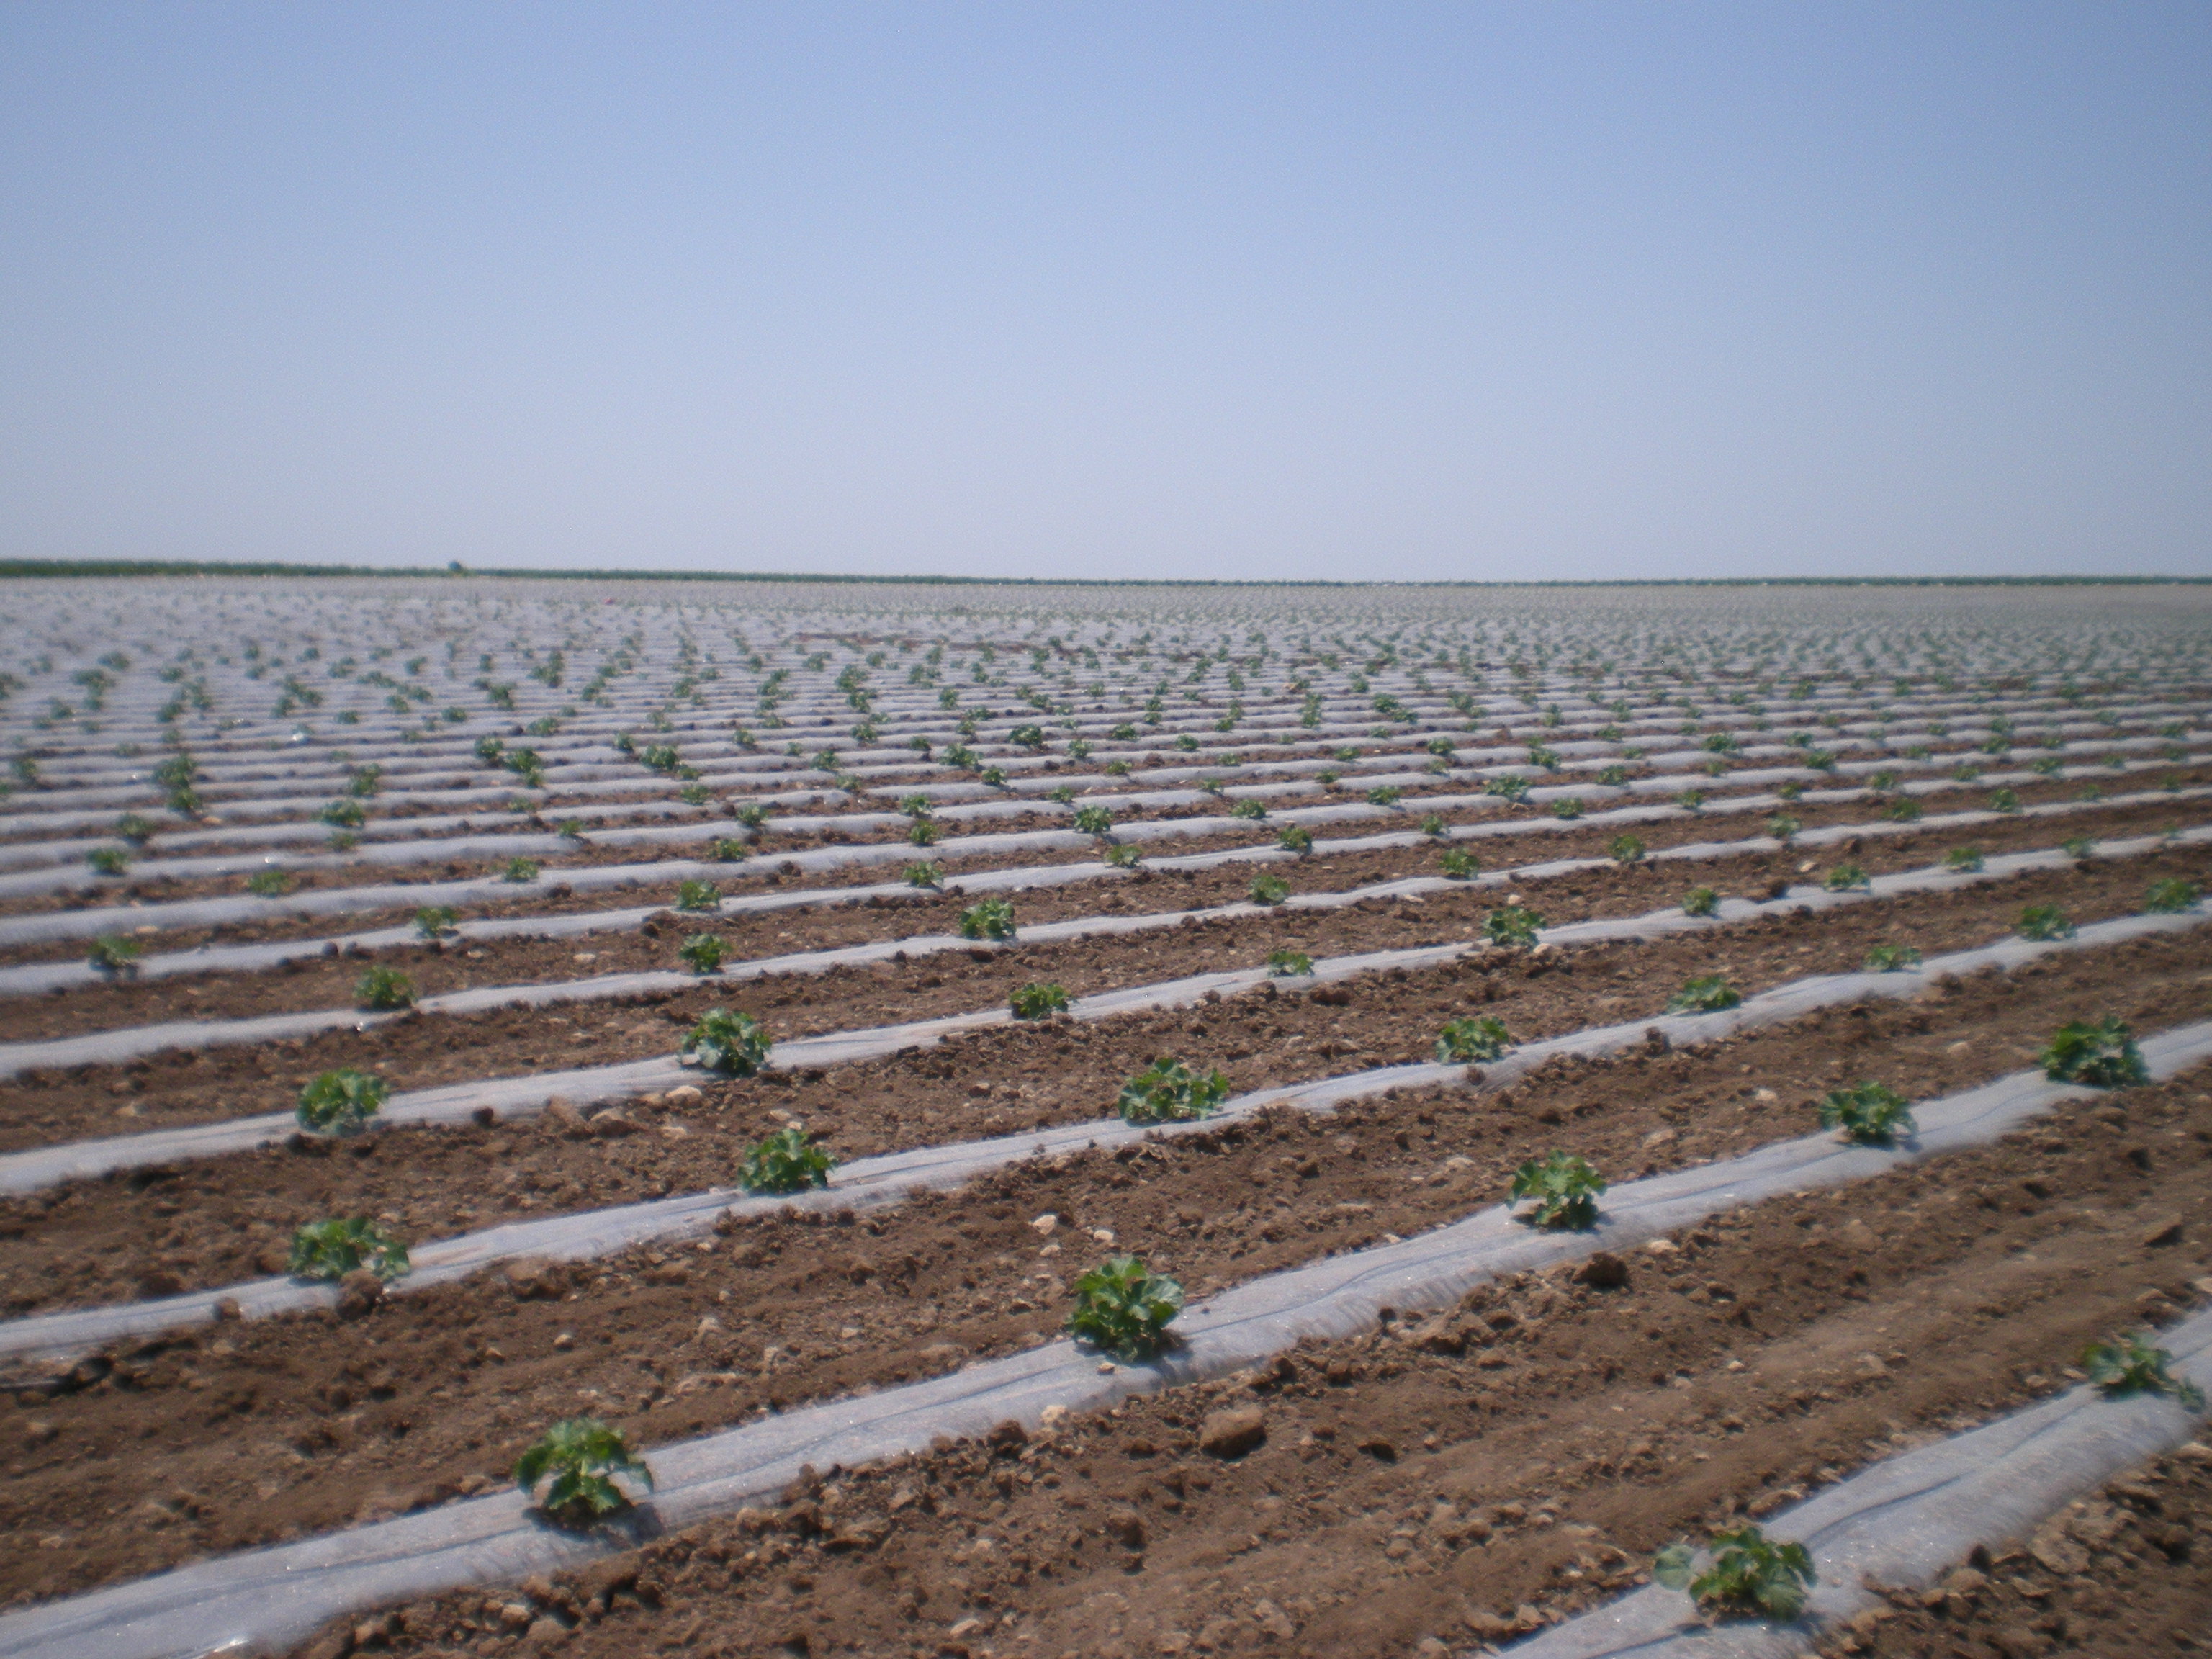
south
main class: Cropland
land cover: Other fresh vegetables
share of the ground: < 10 %
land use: Agriculture (excluding fallow land and kitchen gardens)
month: June
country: ES
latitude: 39.6666
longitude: -3.1818
